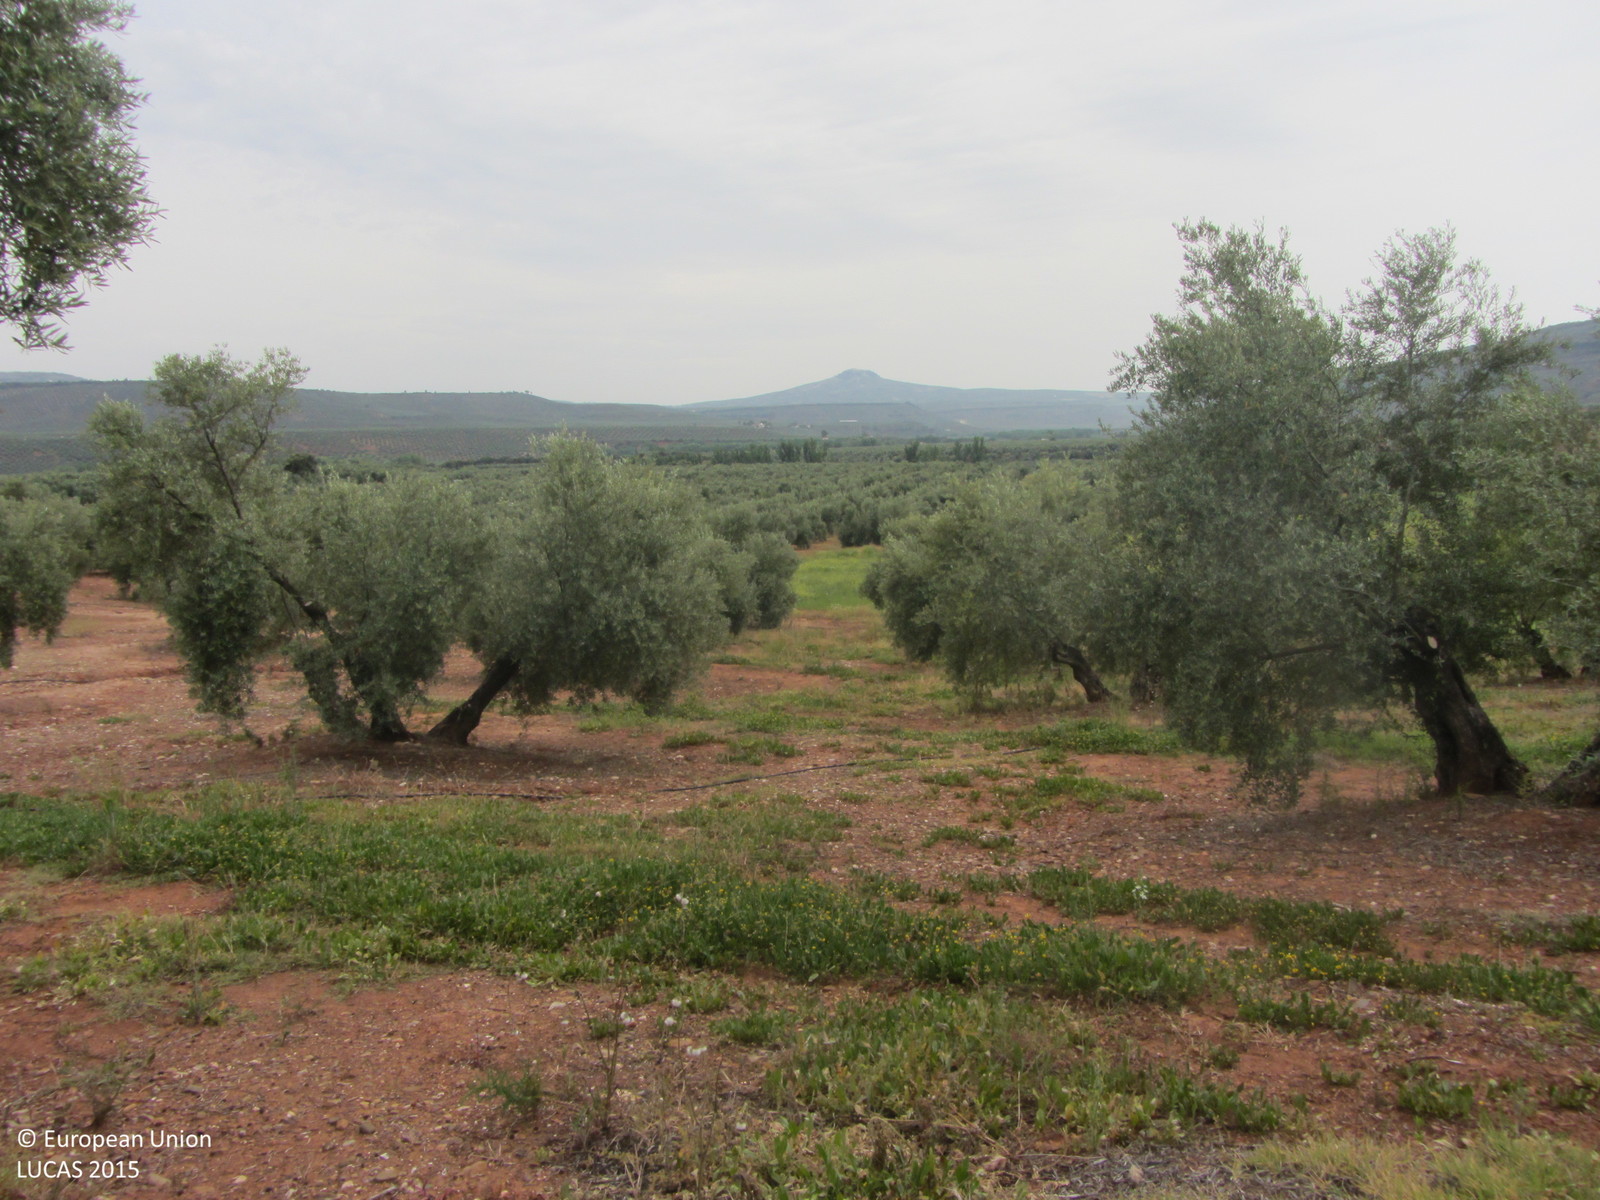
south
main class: Cropland
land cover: Olive groves
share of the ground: 25 - 50 %
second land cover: Spontaneously vegetated surfaces
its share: 50 - 75 %
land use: Agriculture (excluding fallow land and kitchen gardens)
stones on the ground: > 50 %
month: May
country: ES
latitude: 38.2636
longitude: -2.9949
